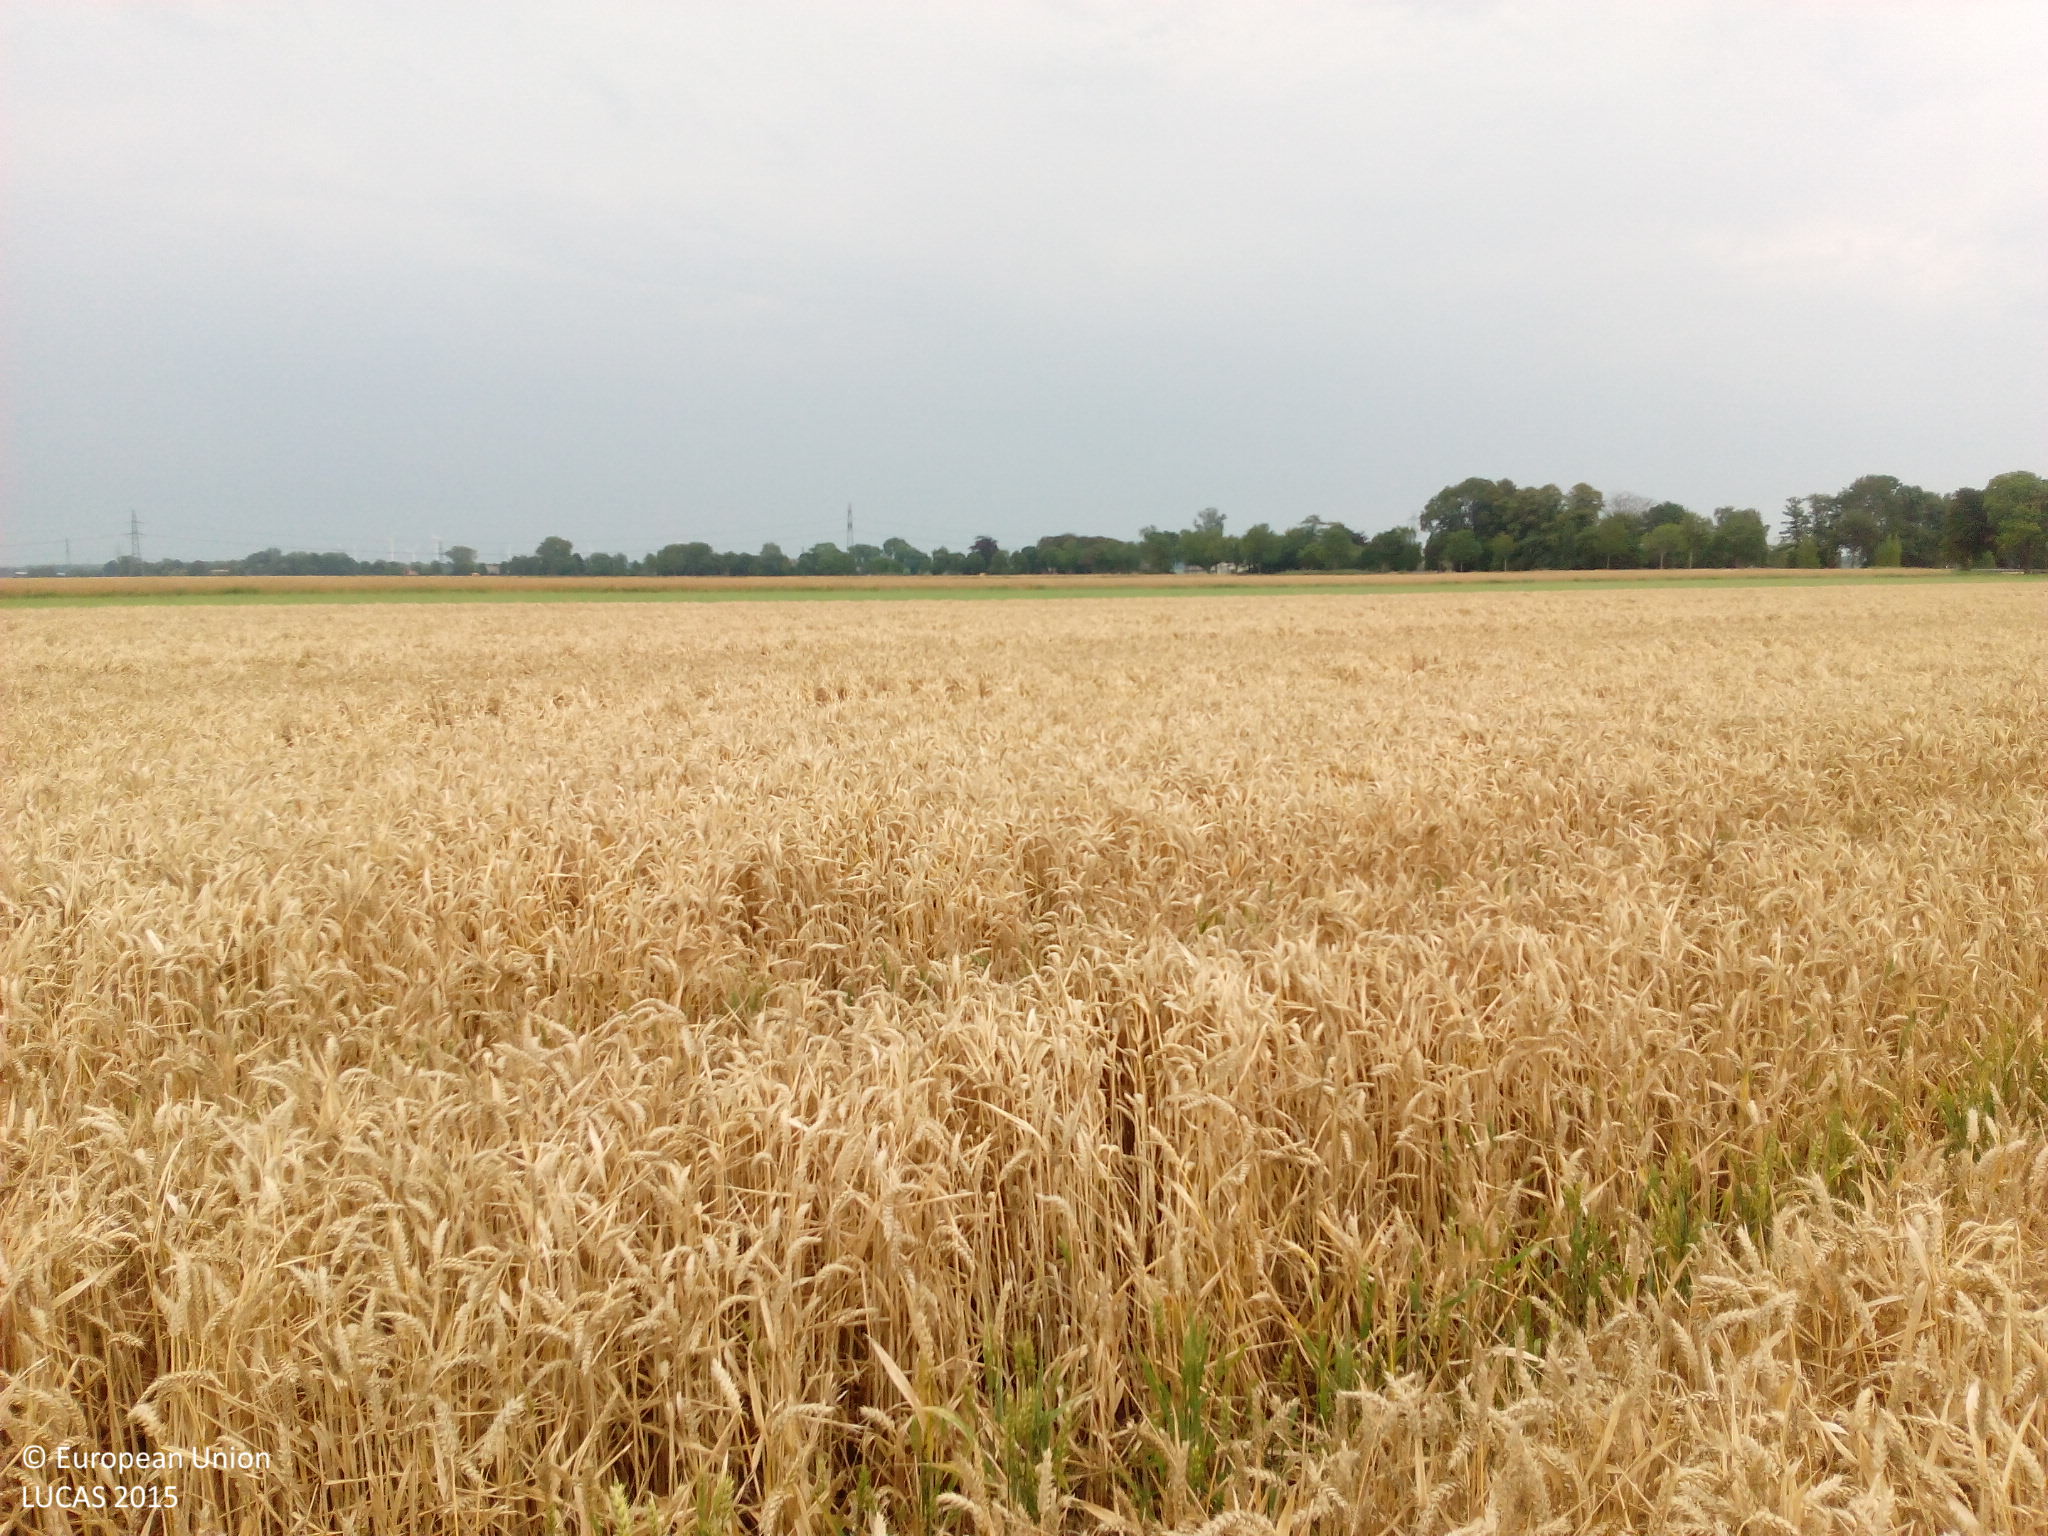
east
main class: Cropland
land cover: Common wheat
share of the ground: > 75 %
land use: Agriculture (excluding fallow land and kitchen gardens)
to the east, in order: Common wheat; Temporary grasslands; Ditches and canals; Rye
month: August
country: DE
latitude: 53.8145
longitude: 9.5598
